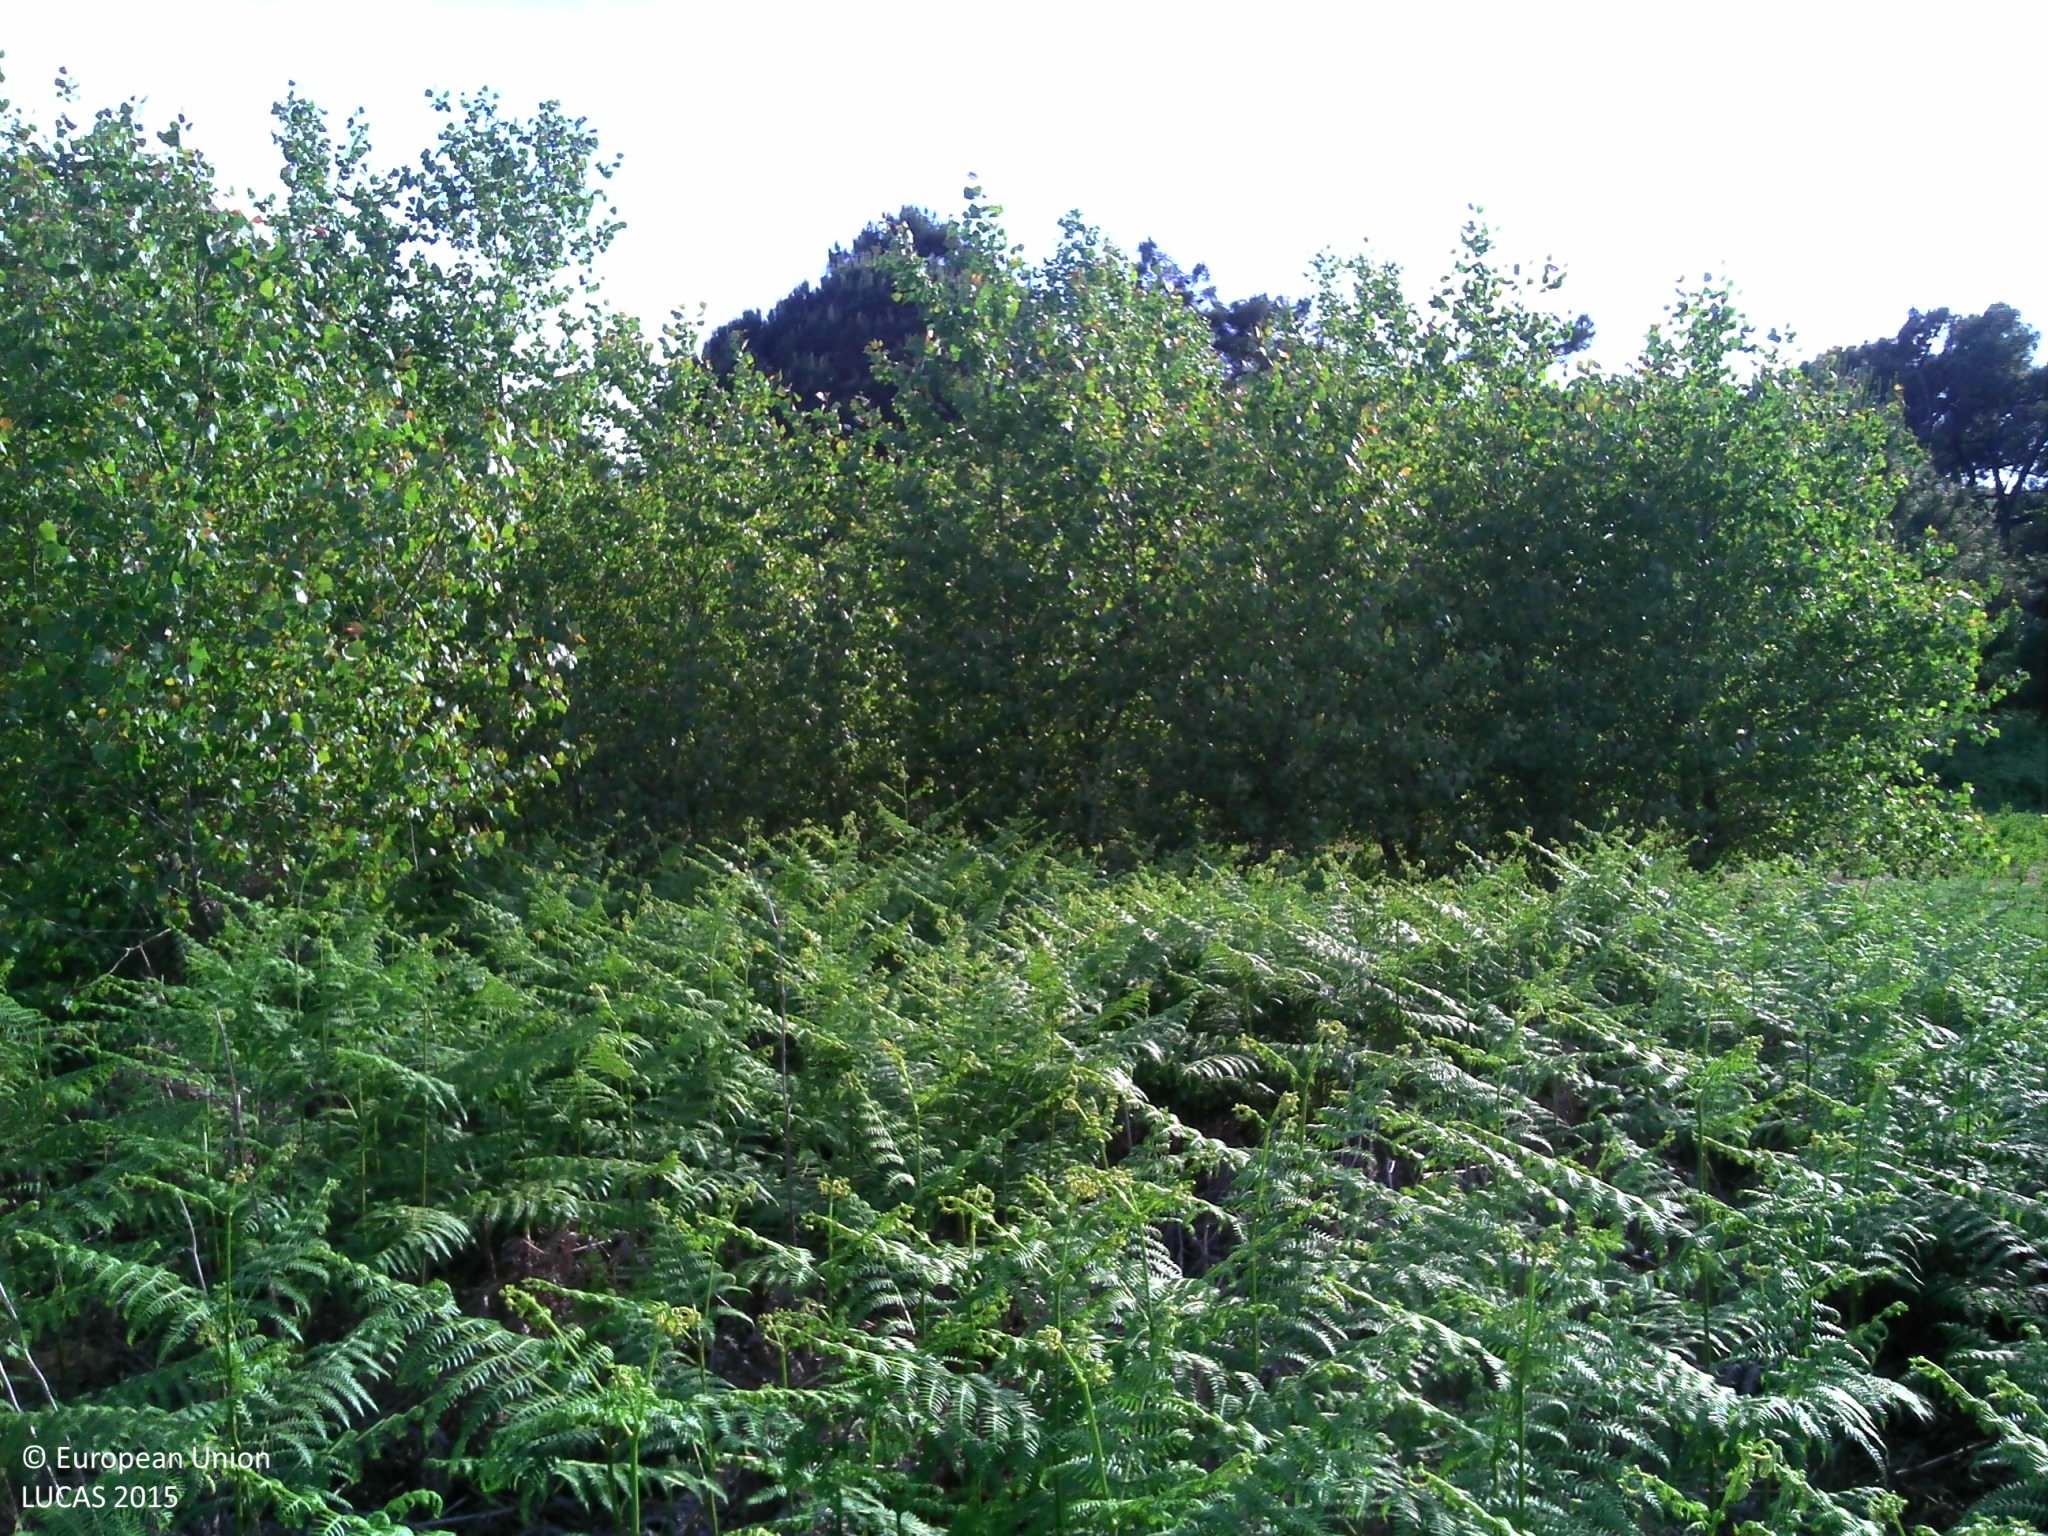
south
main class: Grassland
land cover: Spontaneously vegetated surfaces
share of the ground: > 75 %
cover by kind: herbaceous plants 95 %, shrubs 5 %
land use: Semi-natural and natural areas not in use
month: May
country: FR
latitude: 46.1669
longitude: -1.3145
